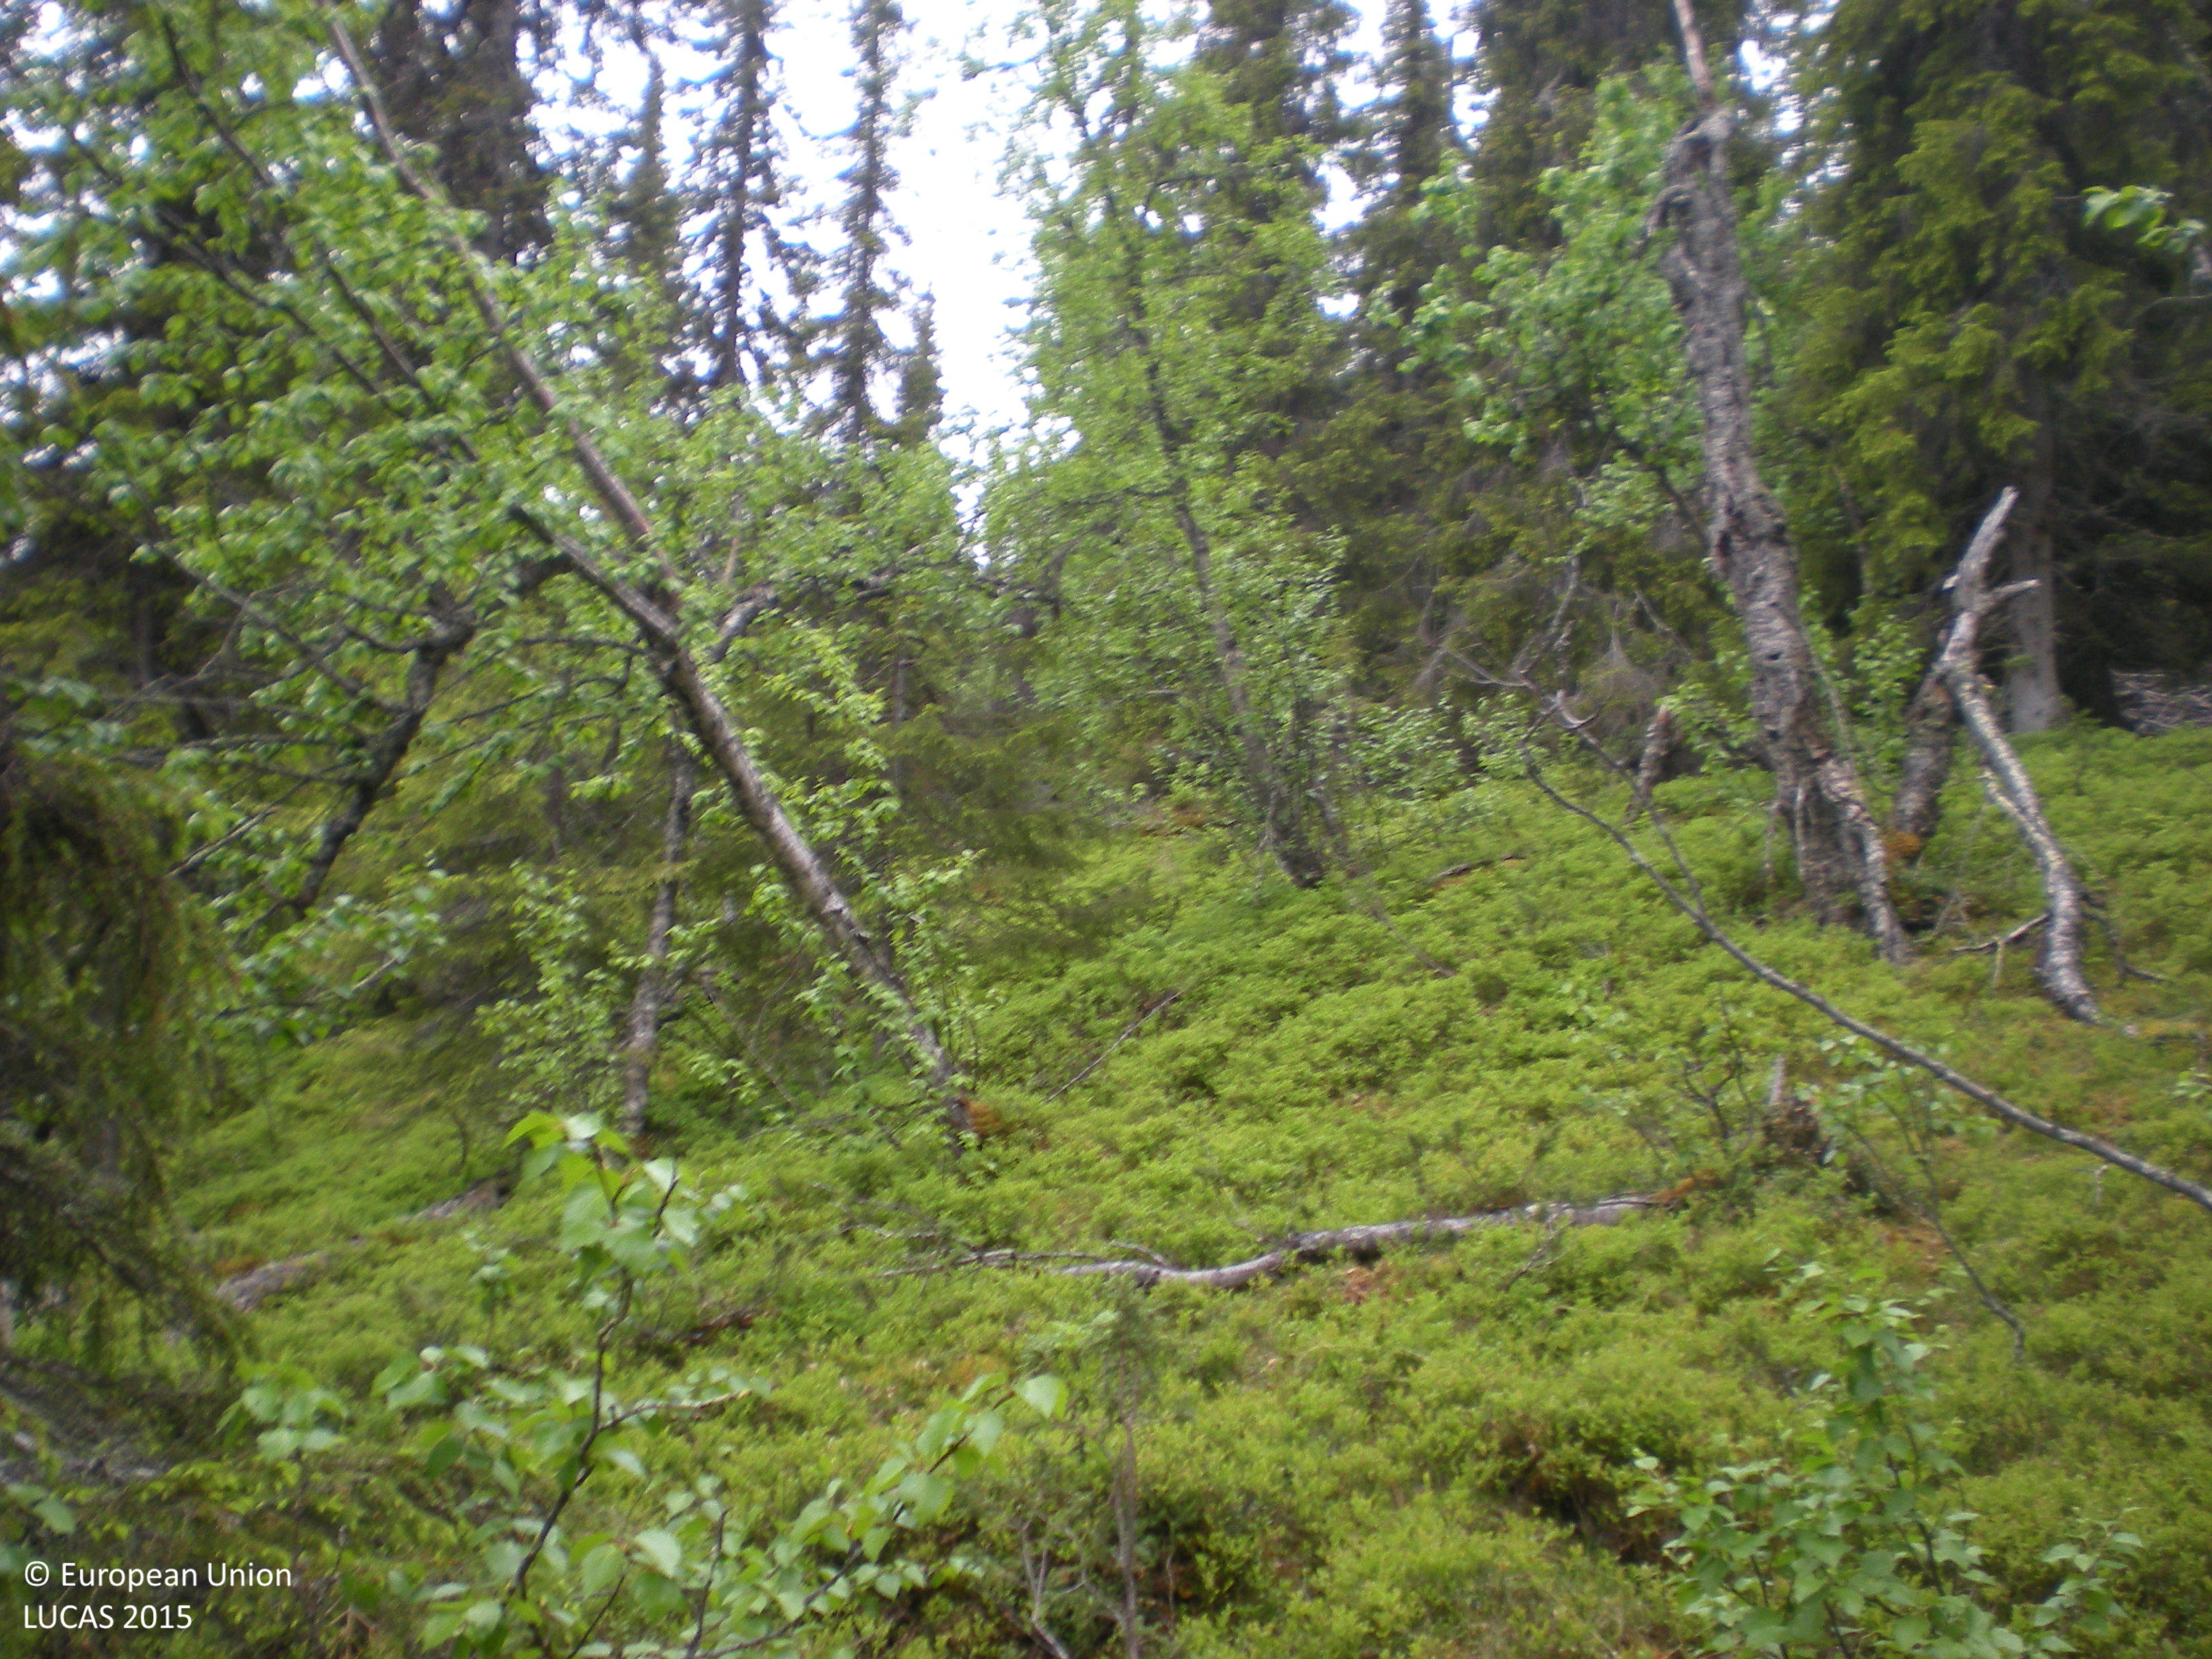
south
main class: Woodland
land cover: Spruce dominated mixed woodland
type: boreal forest
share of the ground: 50 - 75 %
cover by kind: coniferous forest trees 55 %, broadleaved forest trees 20 %, shrubs 20 %, lichens and mosses 5 %
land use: Semi-natural and natural areas not in use
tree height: > 5 m
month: July
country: SE
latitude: 66.1214
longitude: 17.2390
